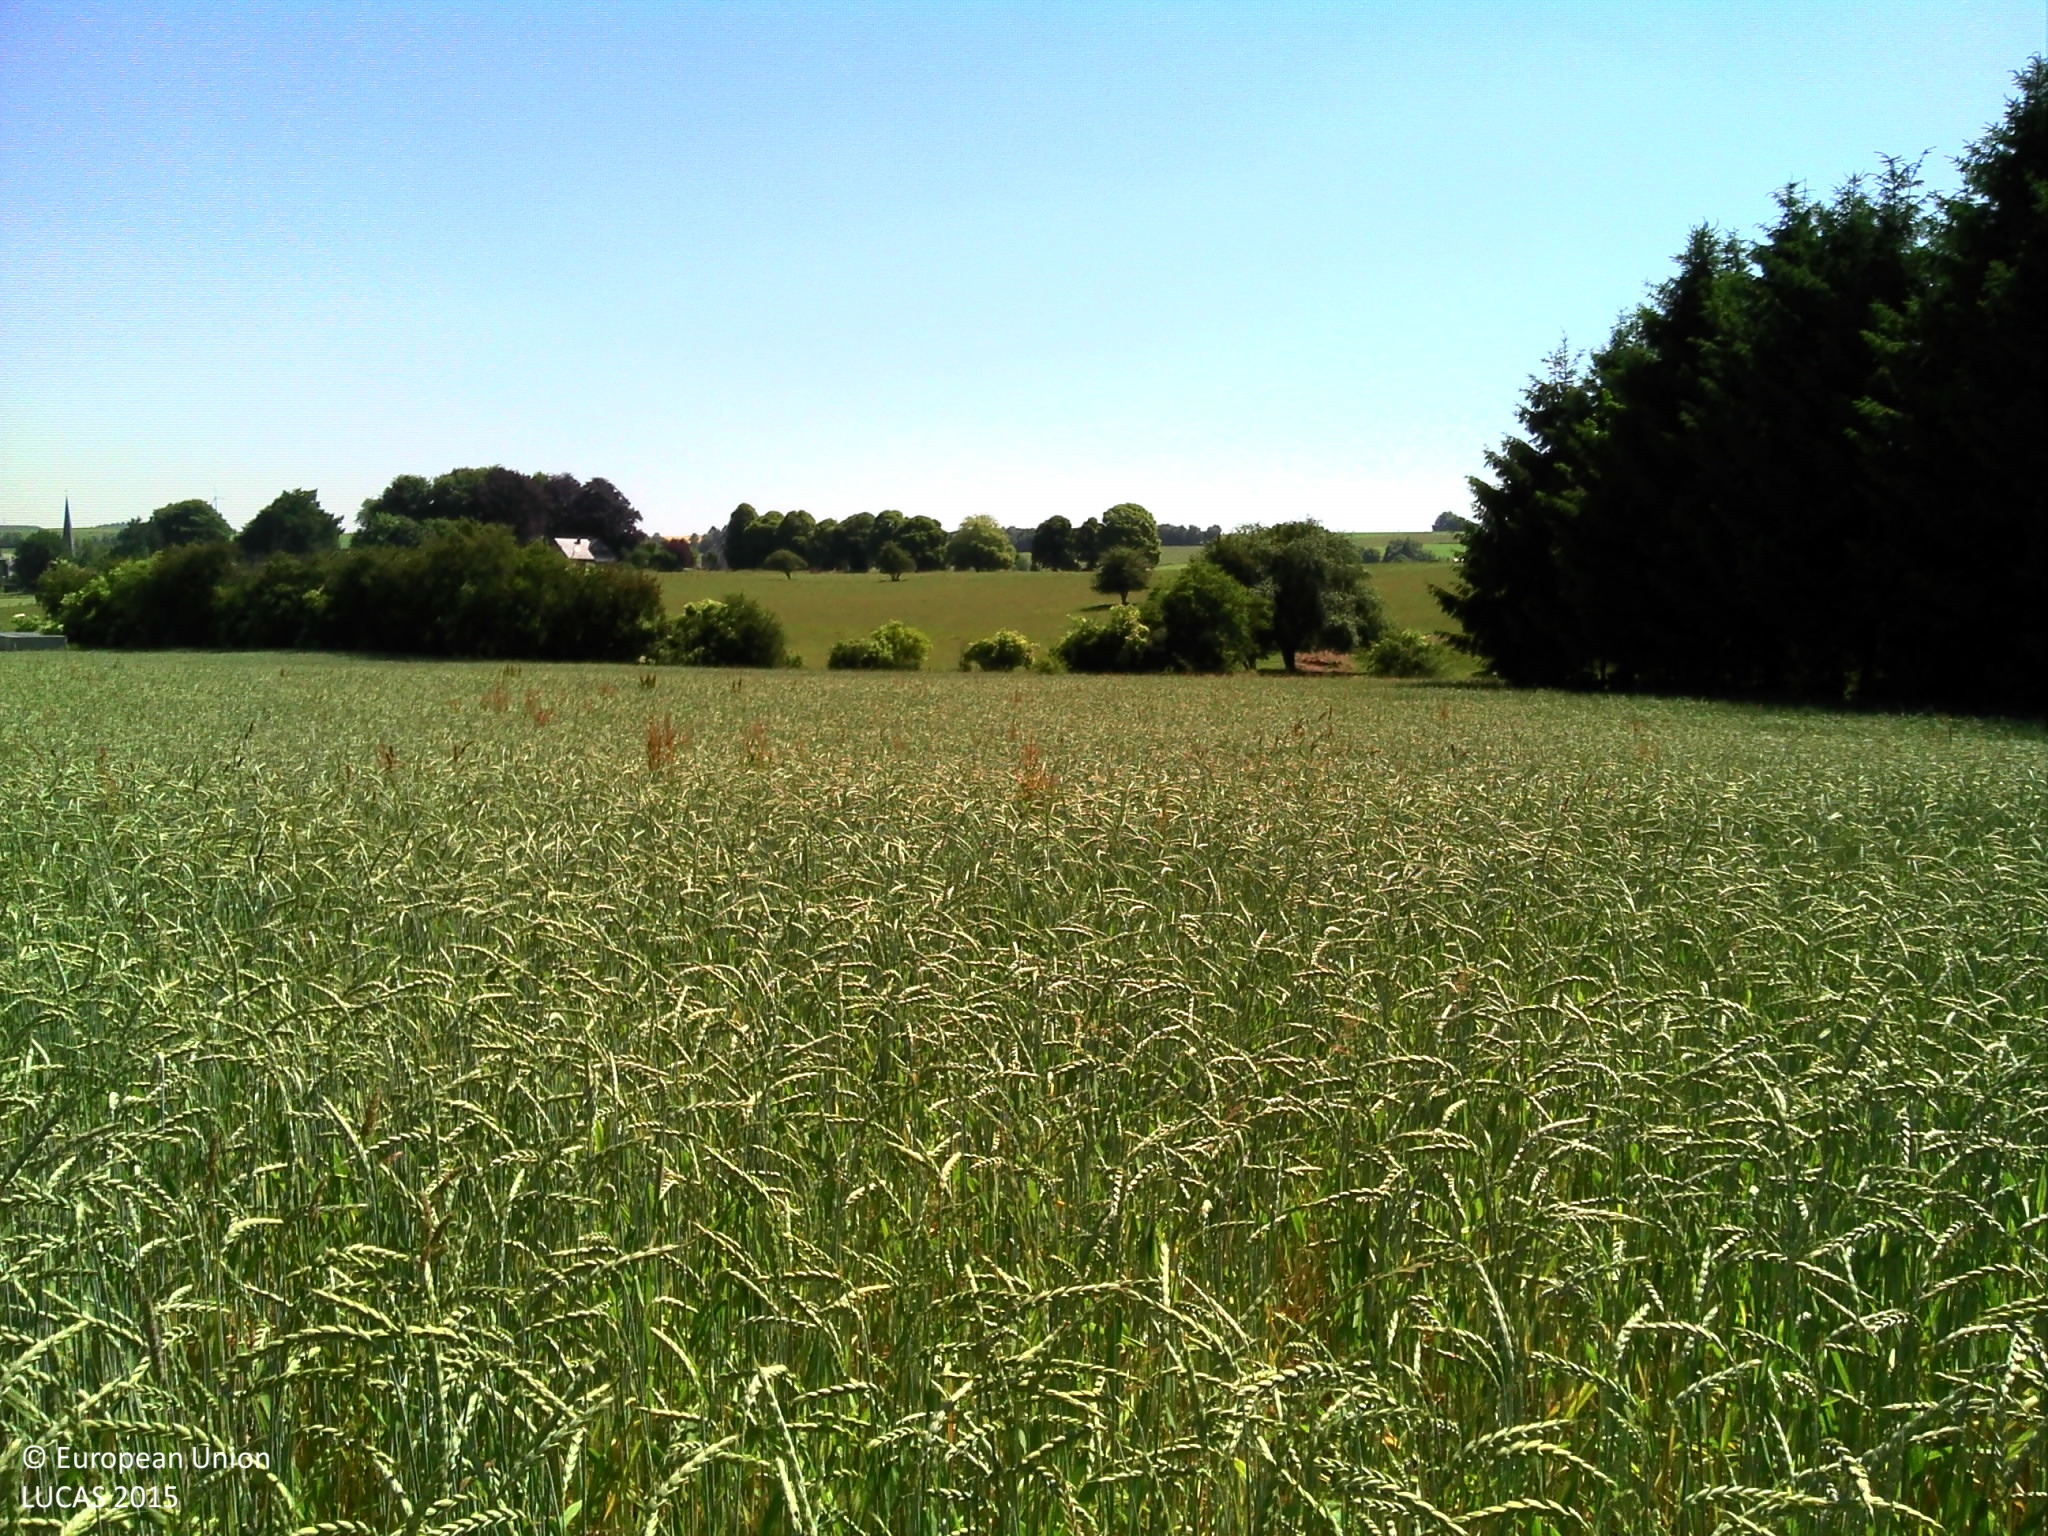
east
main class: Cropland
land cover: Common wheat
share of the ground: > 75 %
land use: Agriculture (excluding fallow land and kitchen gardens)
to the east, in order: Common wheat; Fences; Grassland without tree/shrub cover; Fences; Rivers and streams; Spontaneously vegetated surfaces; Fences; Single bushes/trees; Grassland without tree/shrub cover
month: June
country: BE
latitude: 50.0062
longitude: 5.5195
